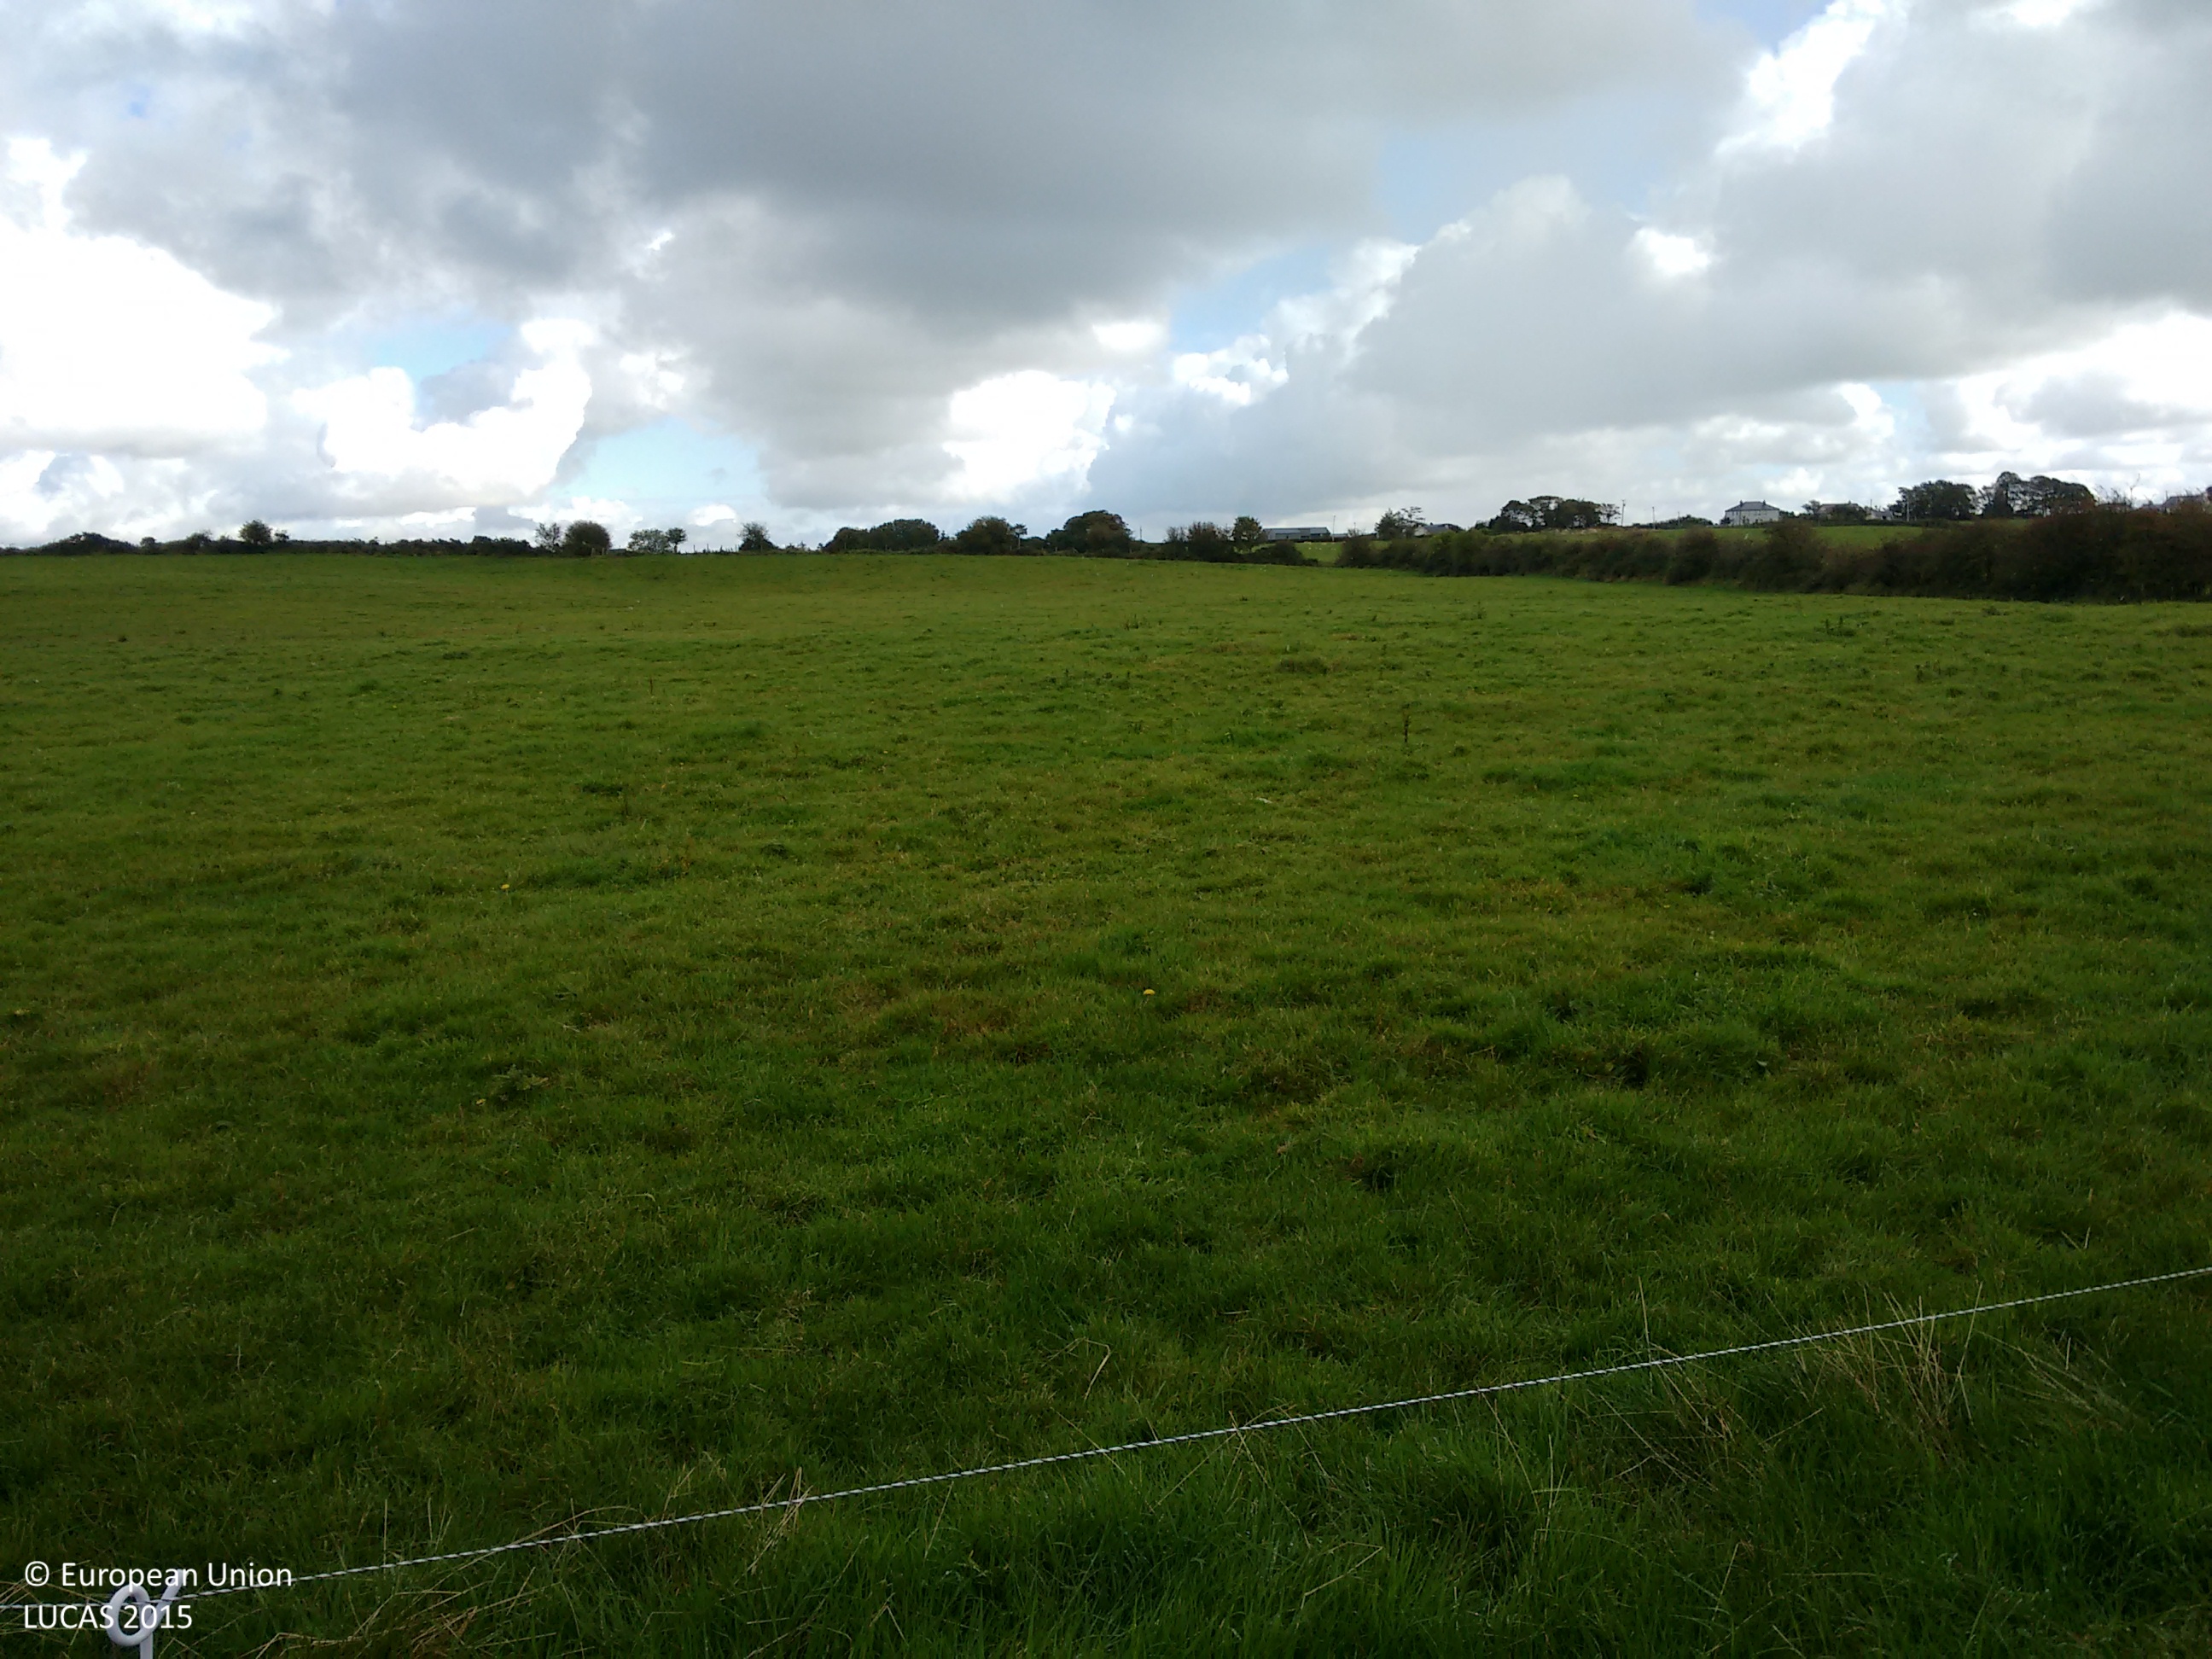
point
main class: Grassland
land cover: Grassland without tree/shrub cover
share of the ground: > 75 %
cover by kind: herbaceous plants 100 %
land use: Agriculture (excluding fallow land and kitchen gardens)
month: September
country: IE
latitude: 53.7698
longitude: -9.2001
